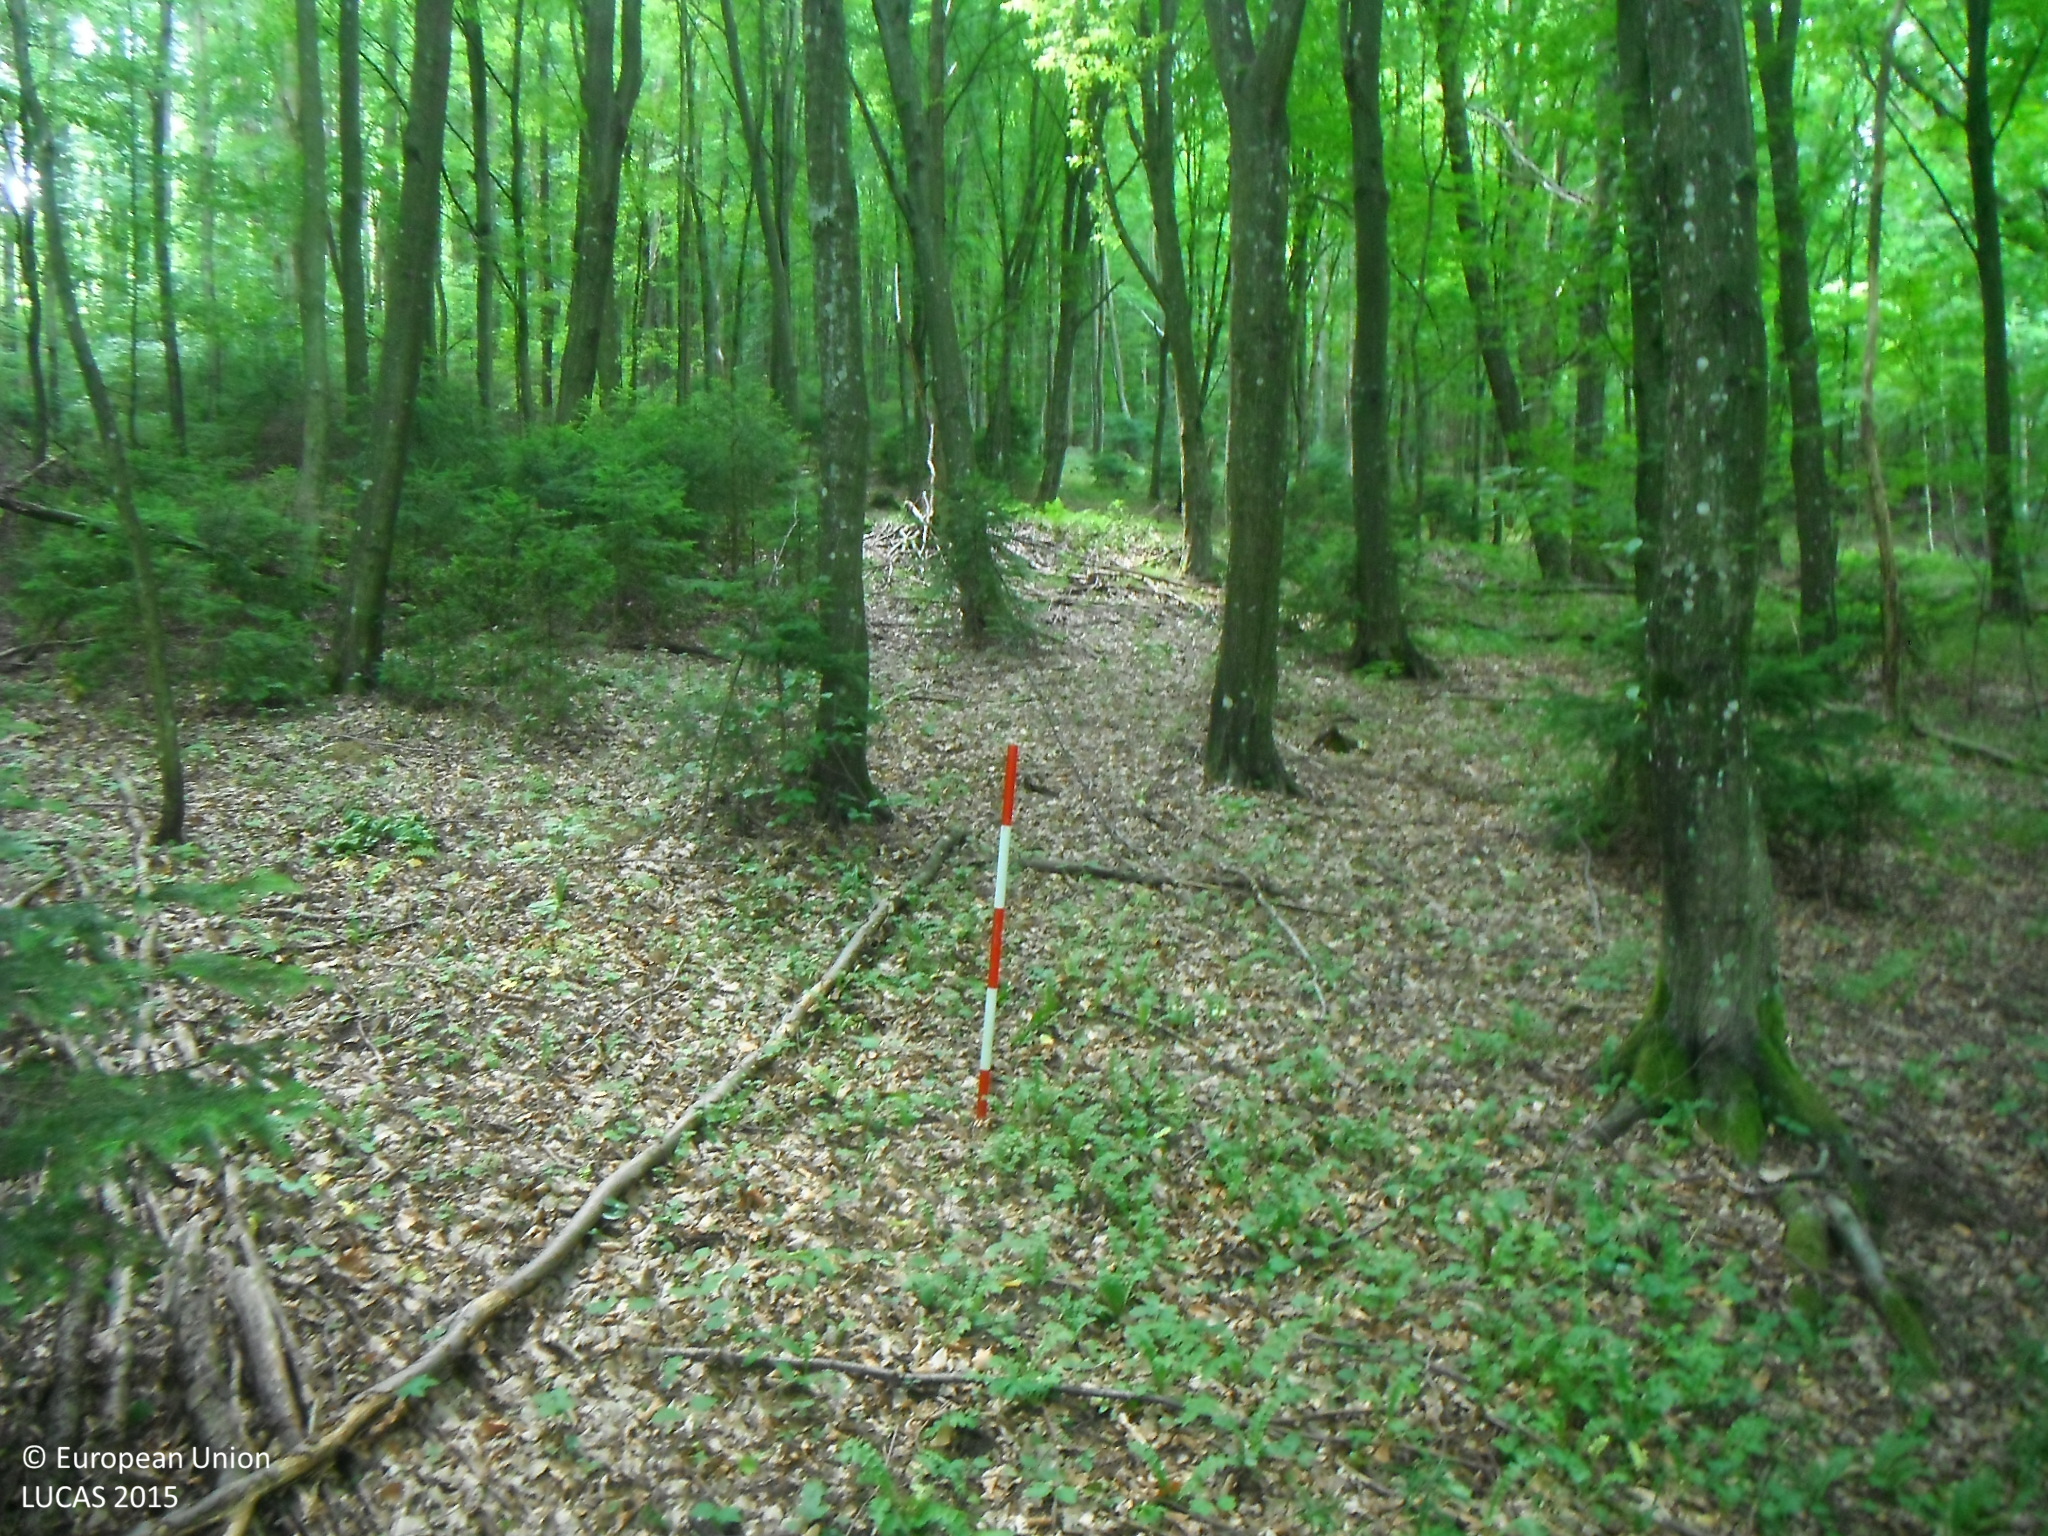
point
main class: Woodland
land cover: Broadleaved woodland
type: beech forest
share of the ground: > 75 %
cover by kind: broadleaved forest trees 100 %
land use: Forestry
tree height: > 5 m
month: June
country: SK
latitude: 48.9087
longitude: 22.3538
